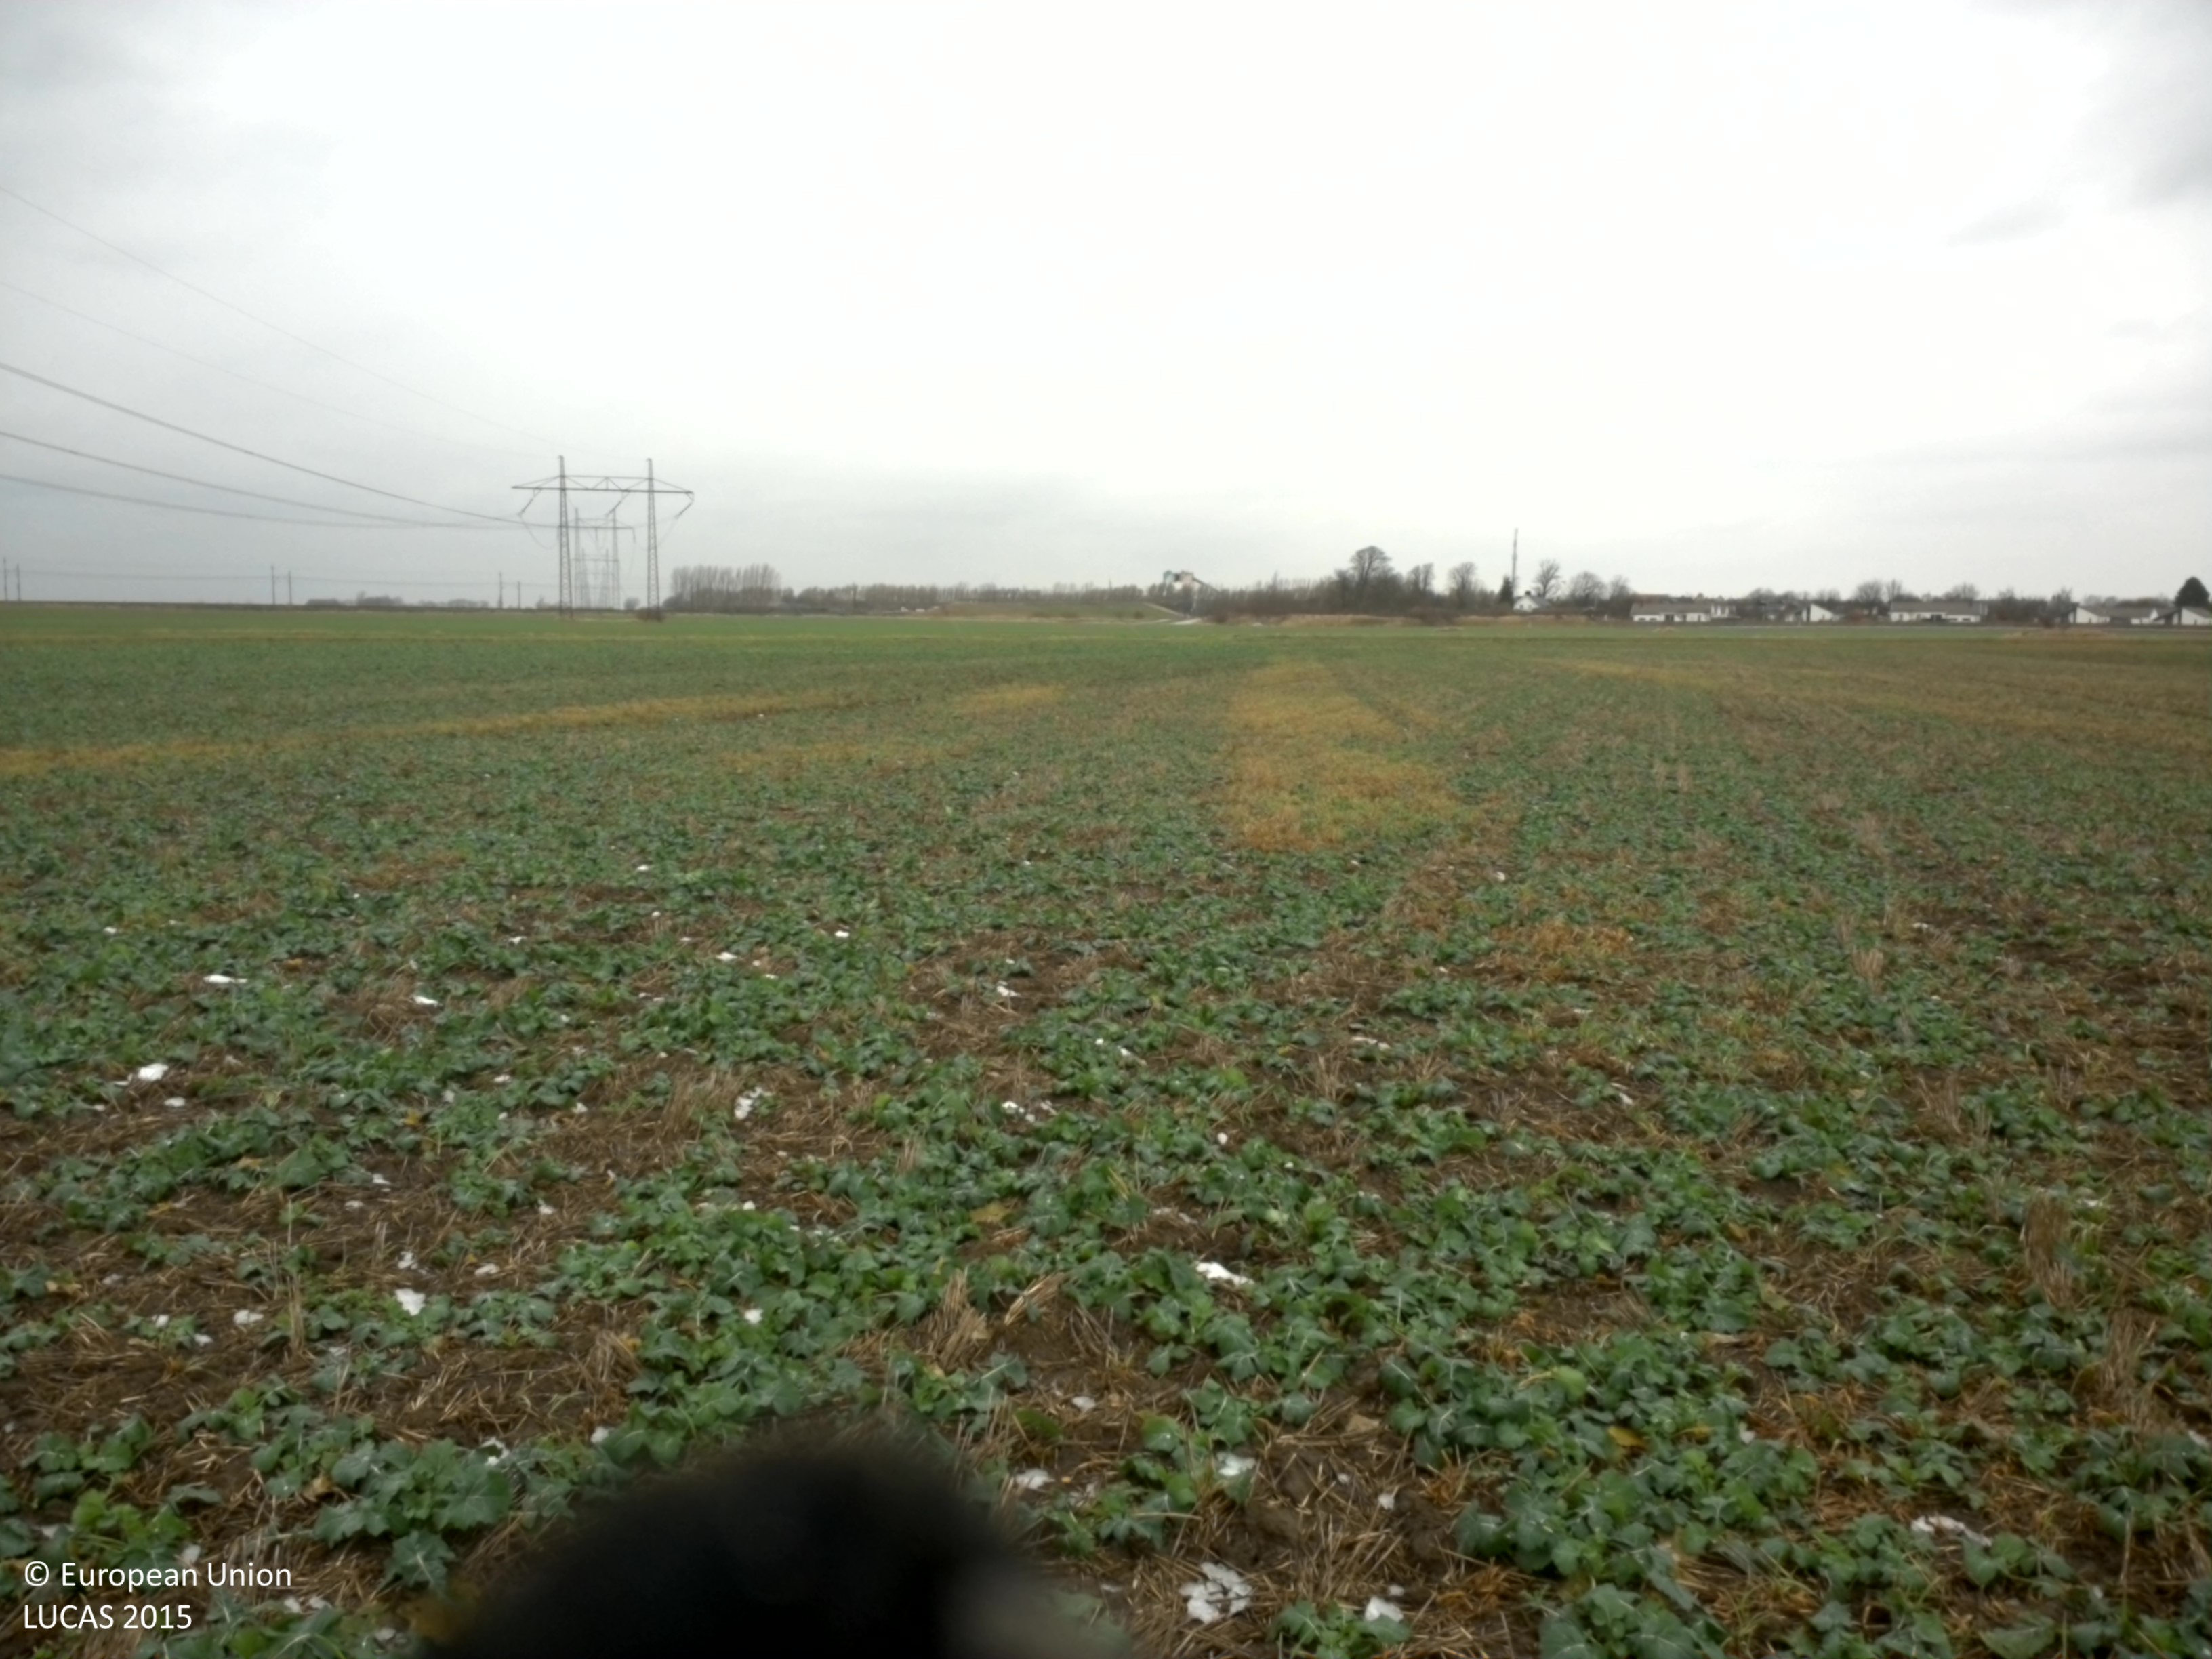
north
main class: Cropland
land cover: Rape and turnip rape
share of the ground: 25 - 50 %
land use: Agriculture (excluding fallow land and kitchen gardens)
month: November
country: SE
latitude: 55.6639
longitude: 13.1296
